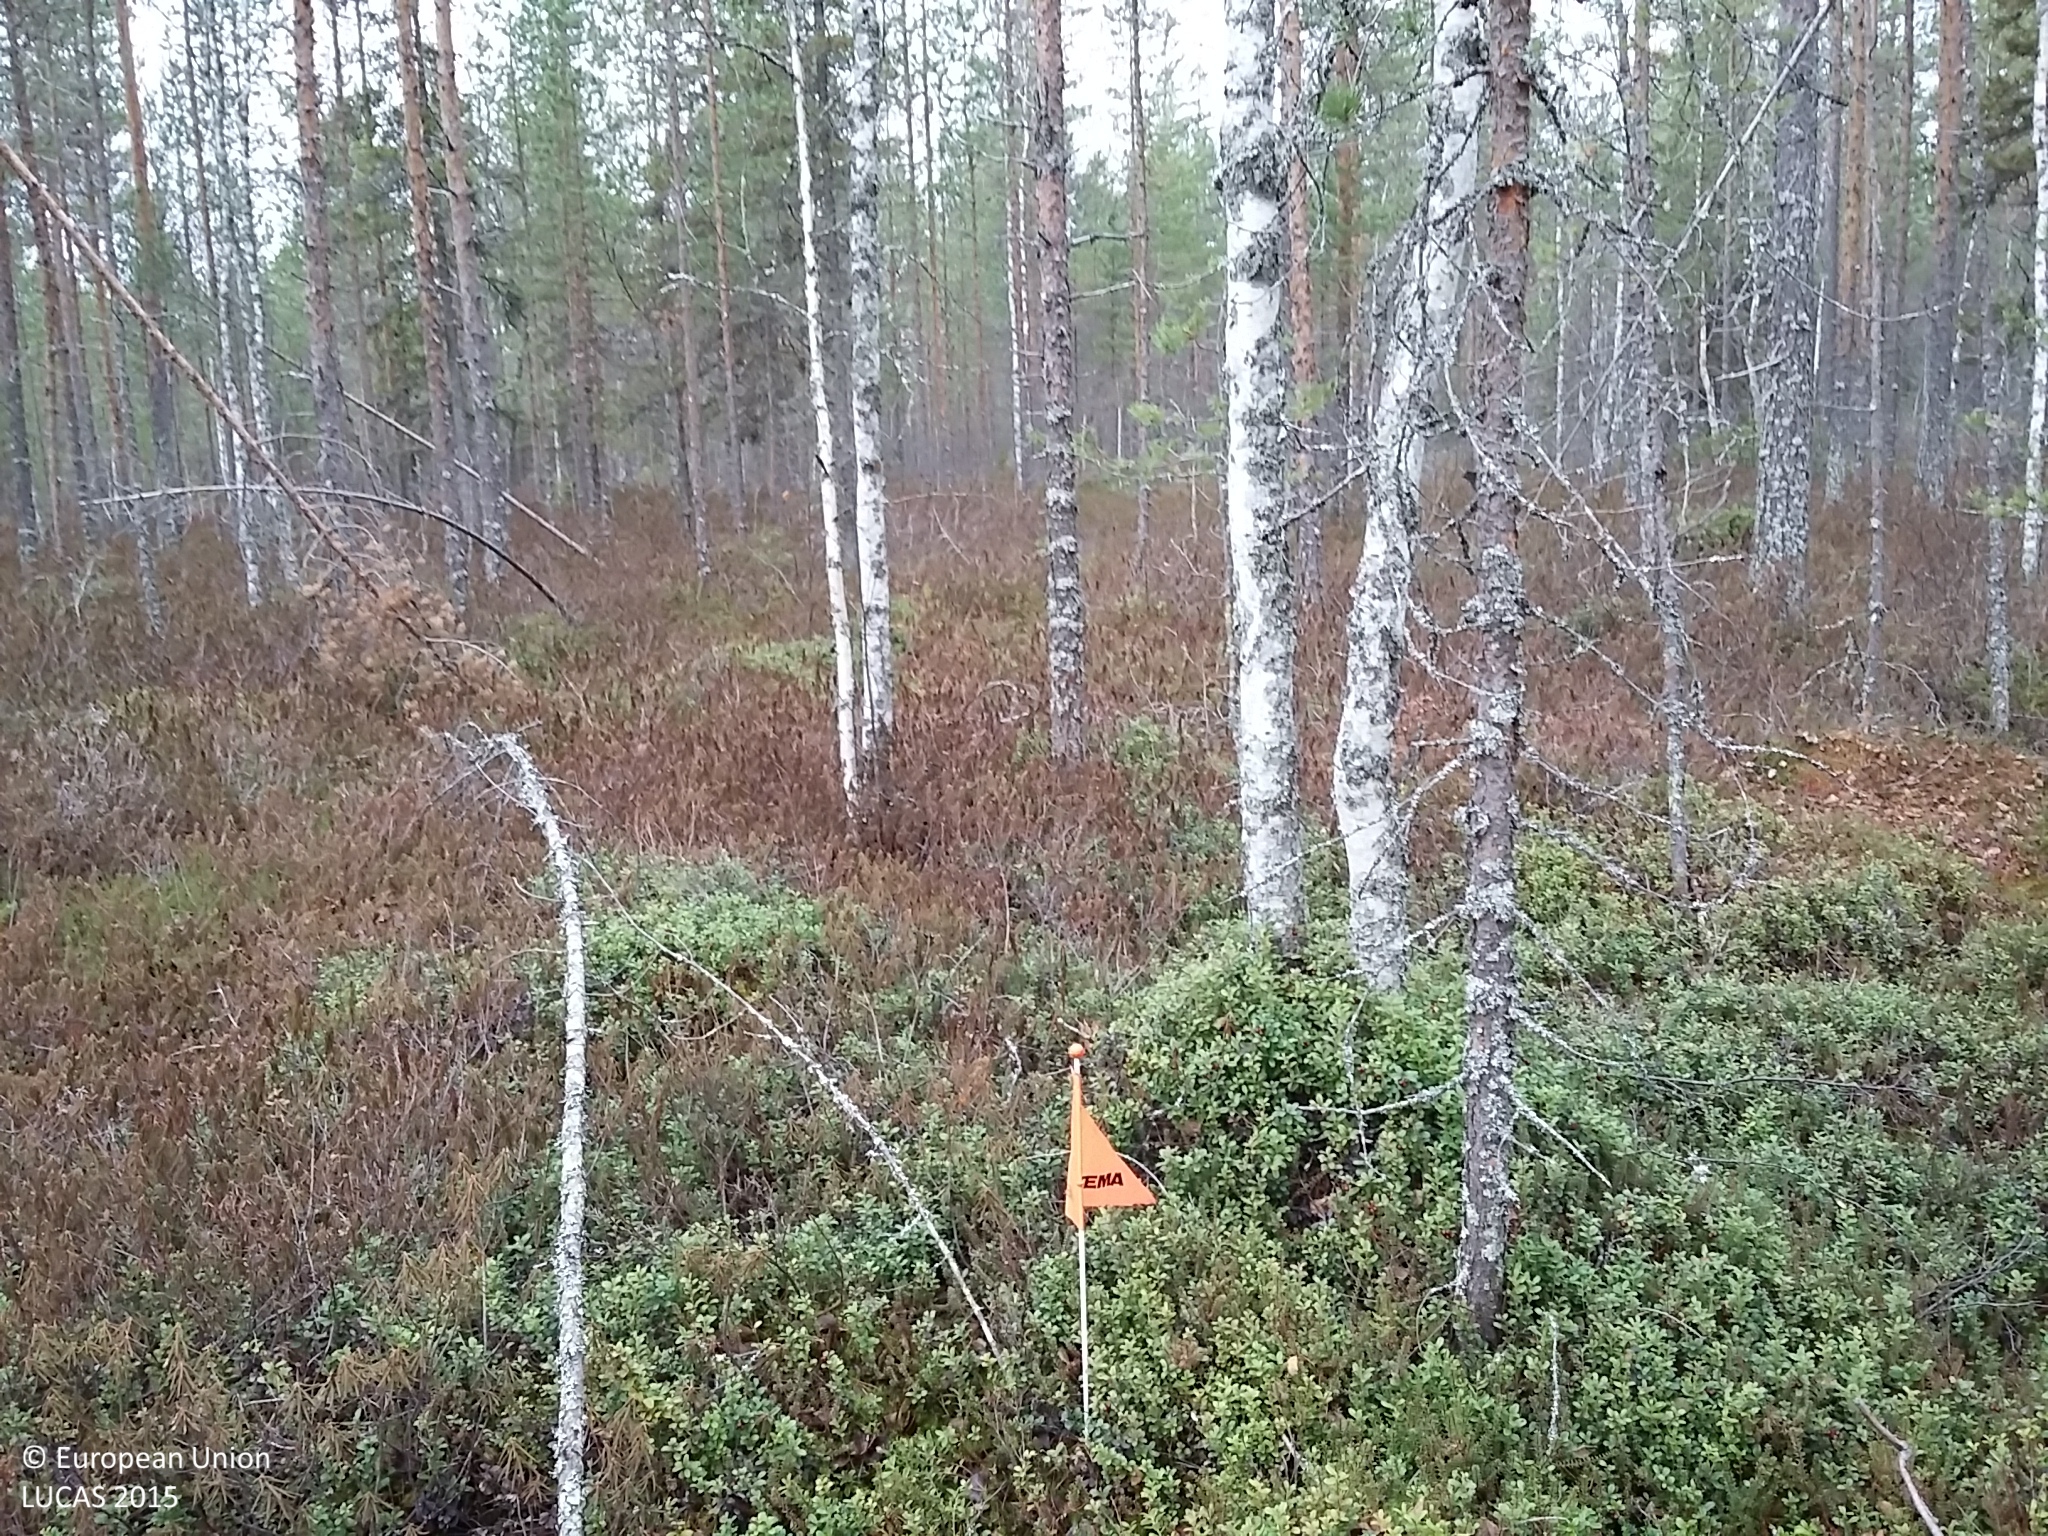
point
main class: Woodland
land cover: Pine dominated mixed woodland
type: boreal forest
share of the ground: > 75 %
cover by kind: coniferous forest trees 55 %, broadleaved forest trees 25 %, shrubs 10 %, lichens and mosses 10 %
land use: Forestry
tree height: > 5 m
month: October
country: FI
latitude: 64.4271
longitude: 25.4758
